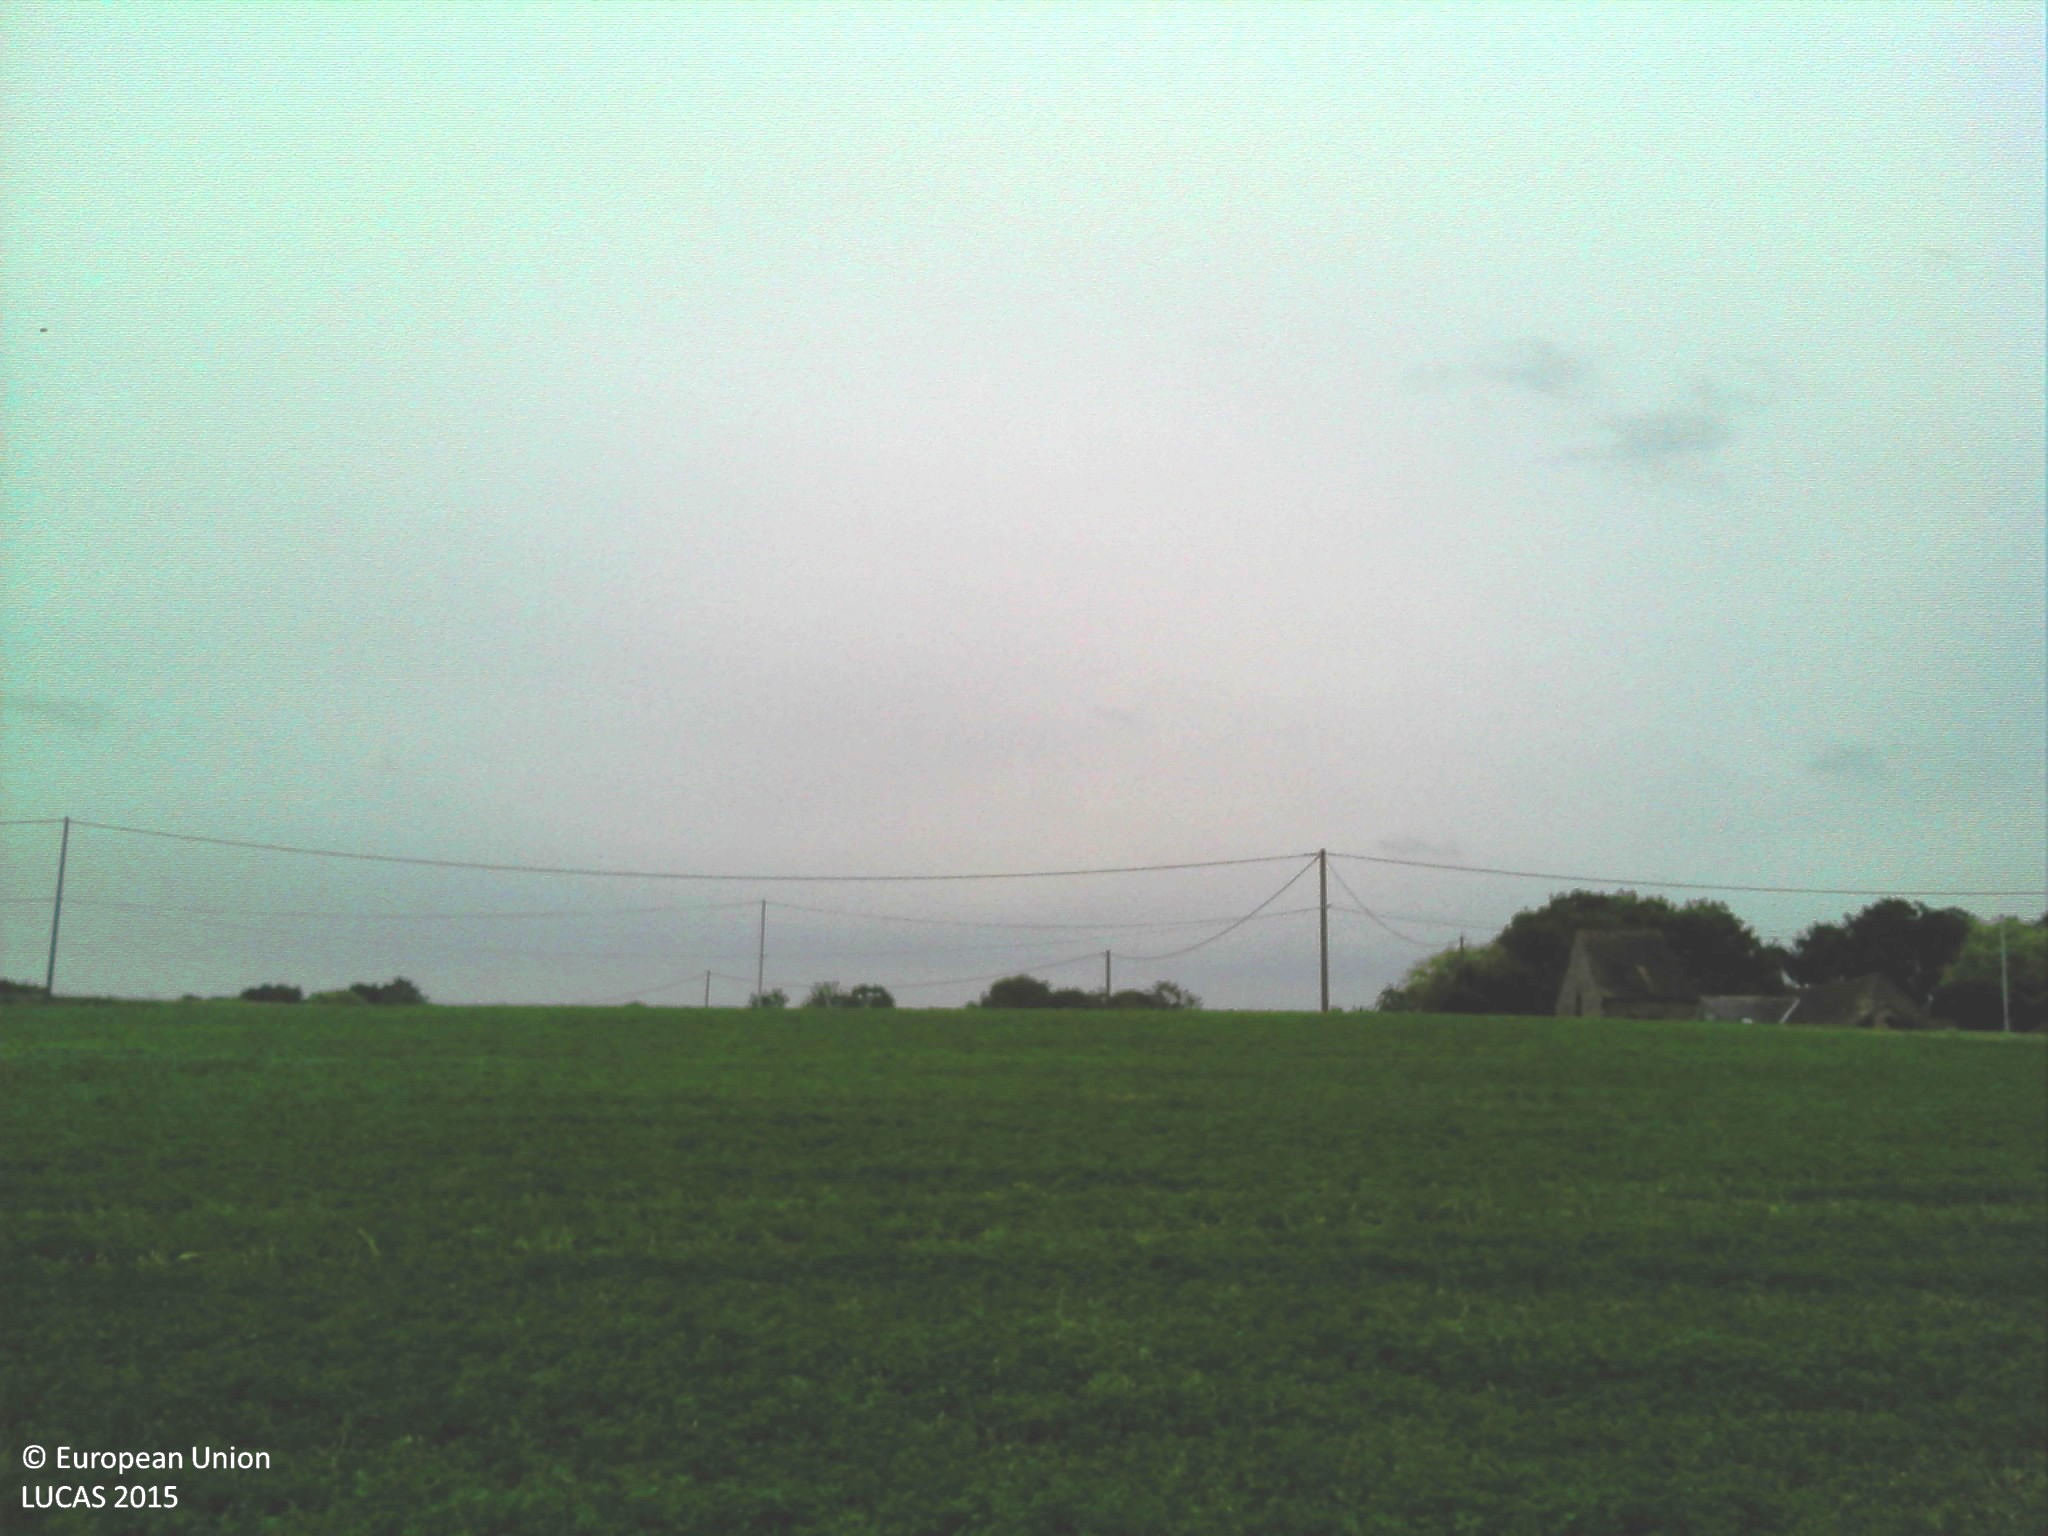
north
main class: Cropland
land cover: Other leguminous and mixtures for fodder
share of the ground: > 75 %
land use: Agriculture (excluding fallow land and kitchen gardens)
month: June
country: FR
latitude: 48.2361
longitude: -0.0329
